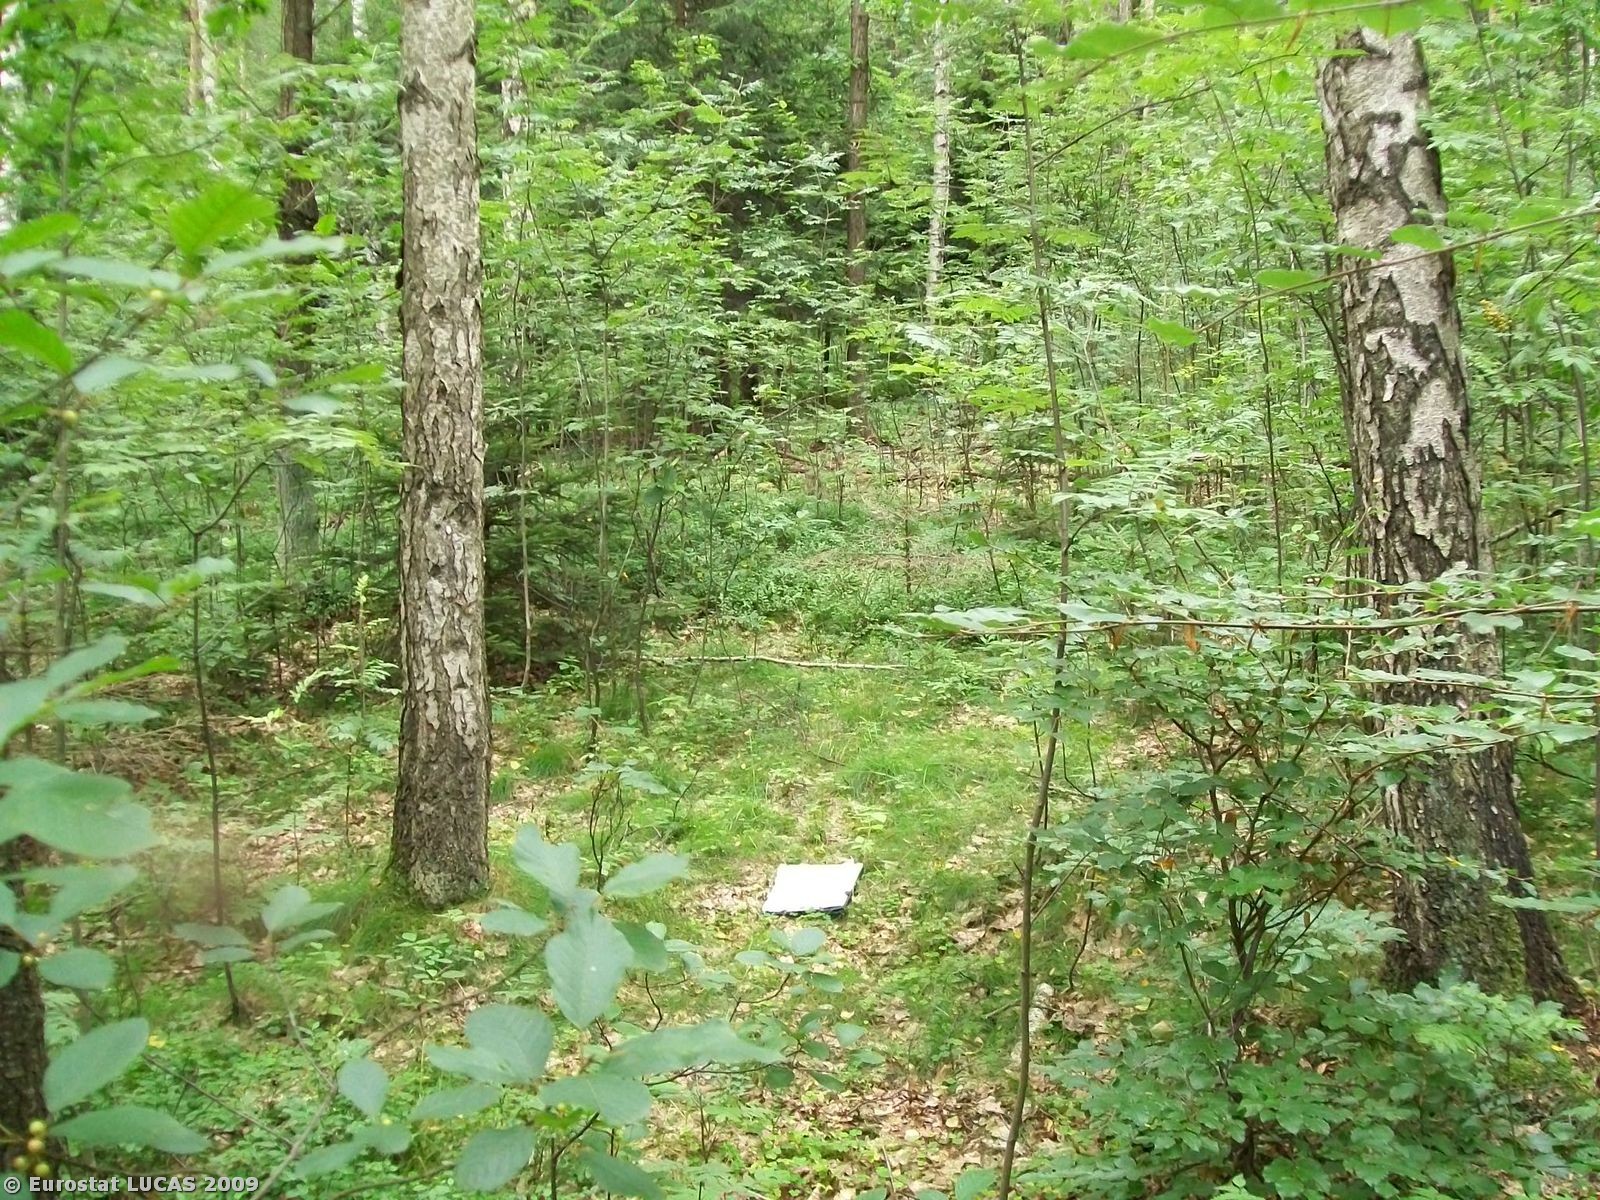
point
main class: Woodland
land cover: Mixed woodland
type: hemiboreal forest and nemoral coniferous forest and mixed broadleaved-coniferous forest
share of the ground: > 75 %
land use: Forestry
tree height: > 5 m
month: July
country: PL
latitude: 51.0228
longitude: 15.1500
